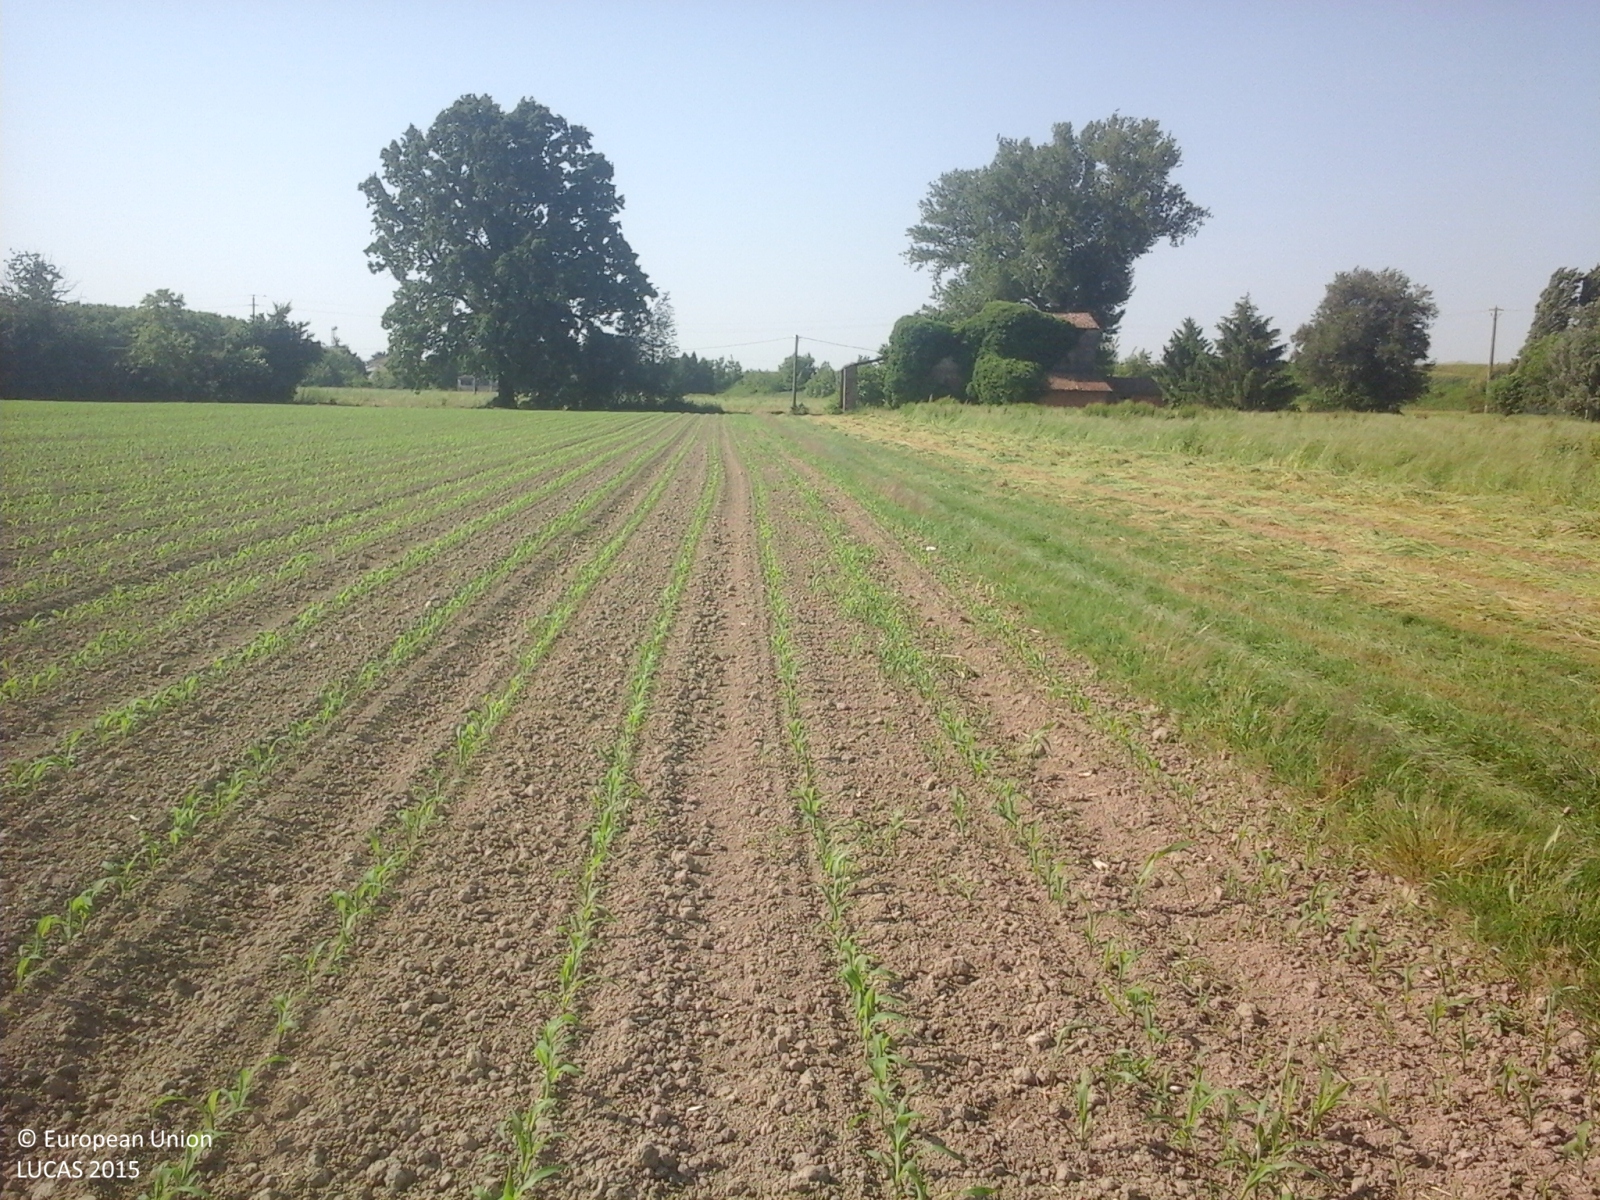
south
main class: Cropland
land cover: Maize
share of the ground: < 10 %
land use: Agriculture (excluding fallow land and kitchen gardens)
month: May
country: IT
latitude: 45.0497
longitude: 10.9251
